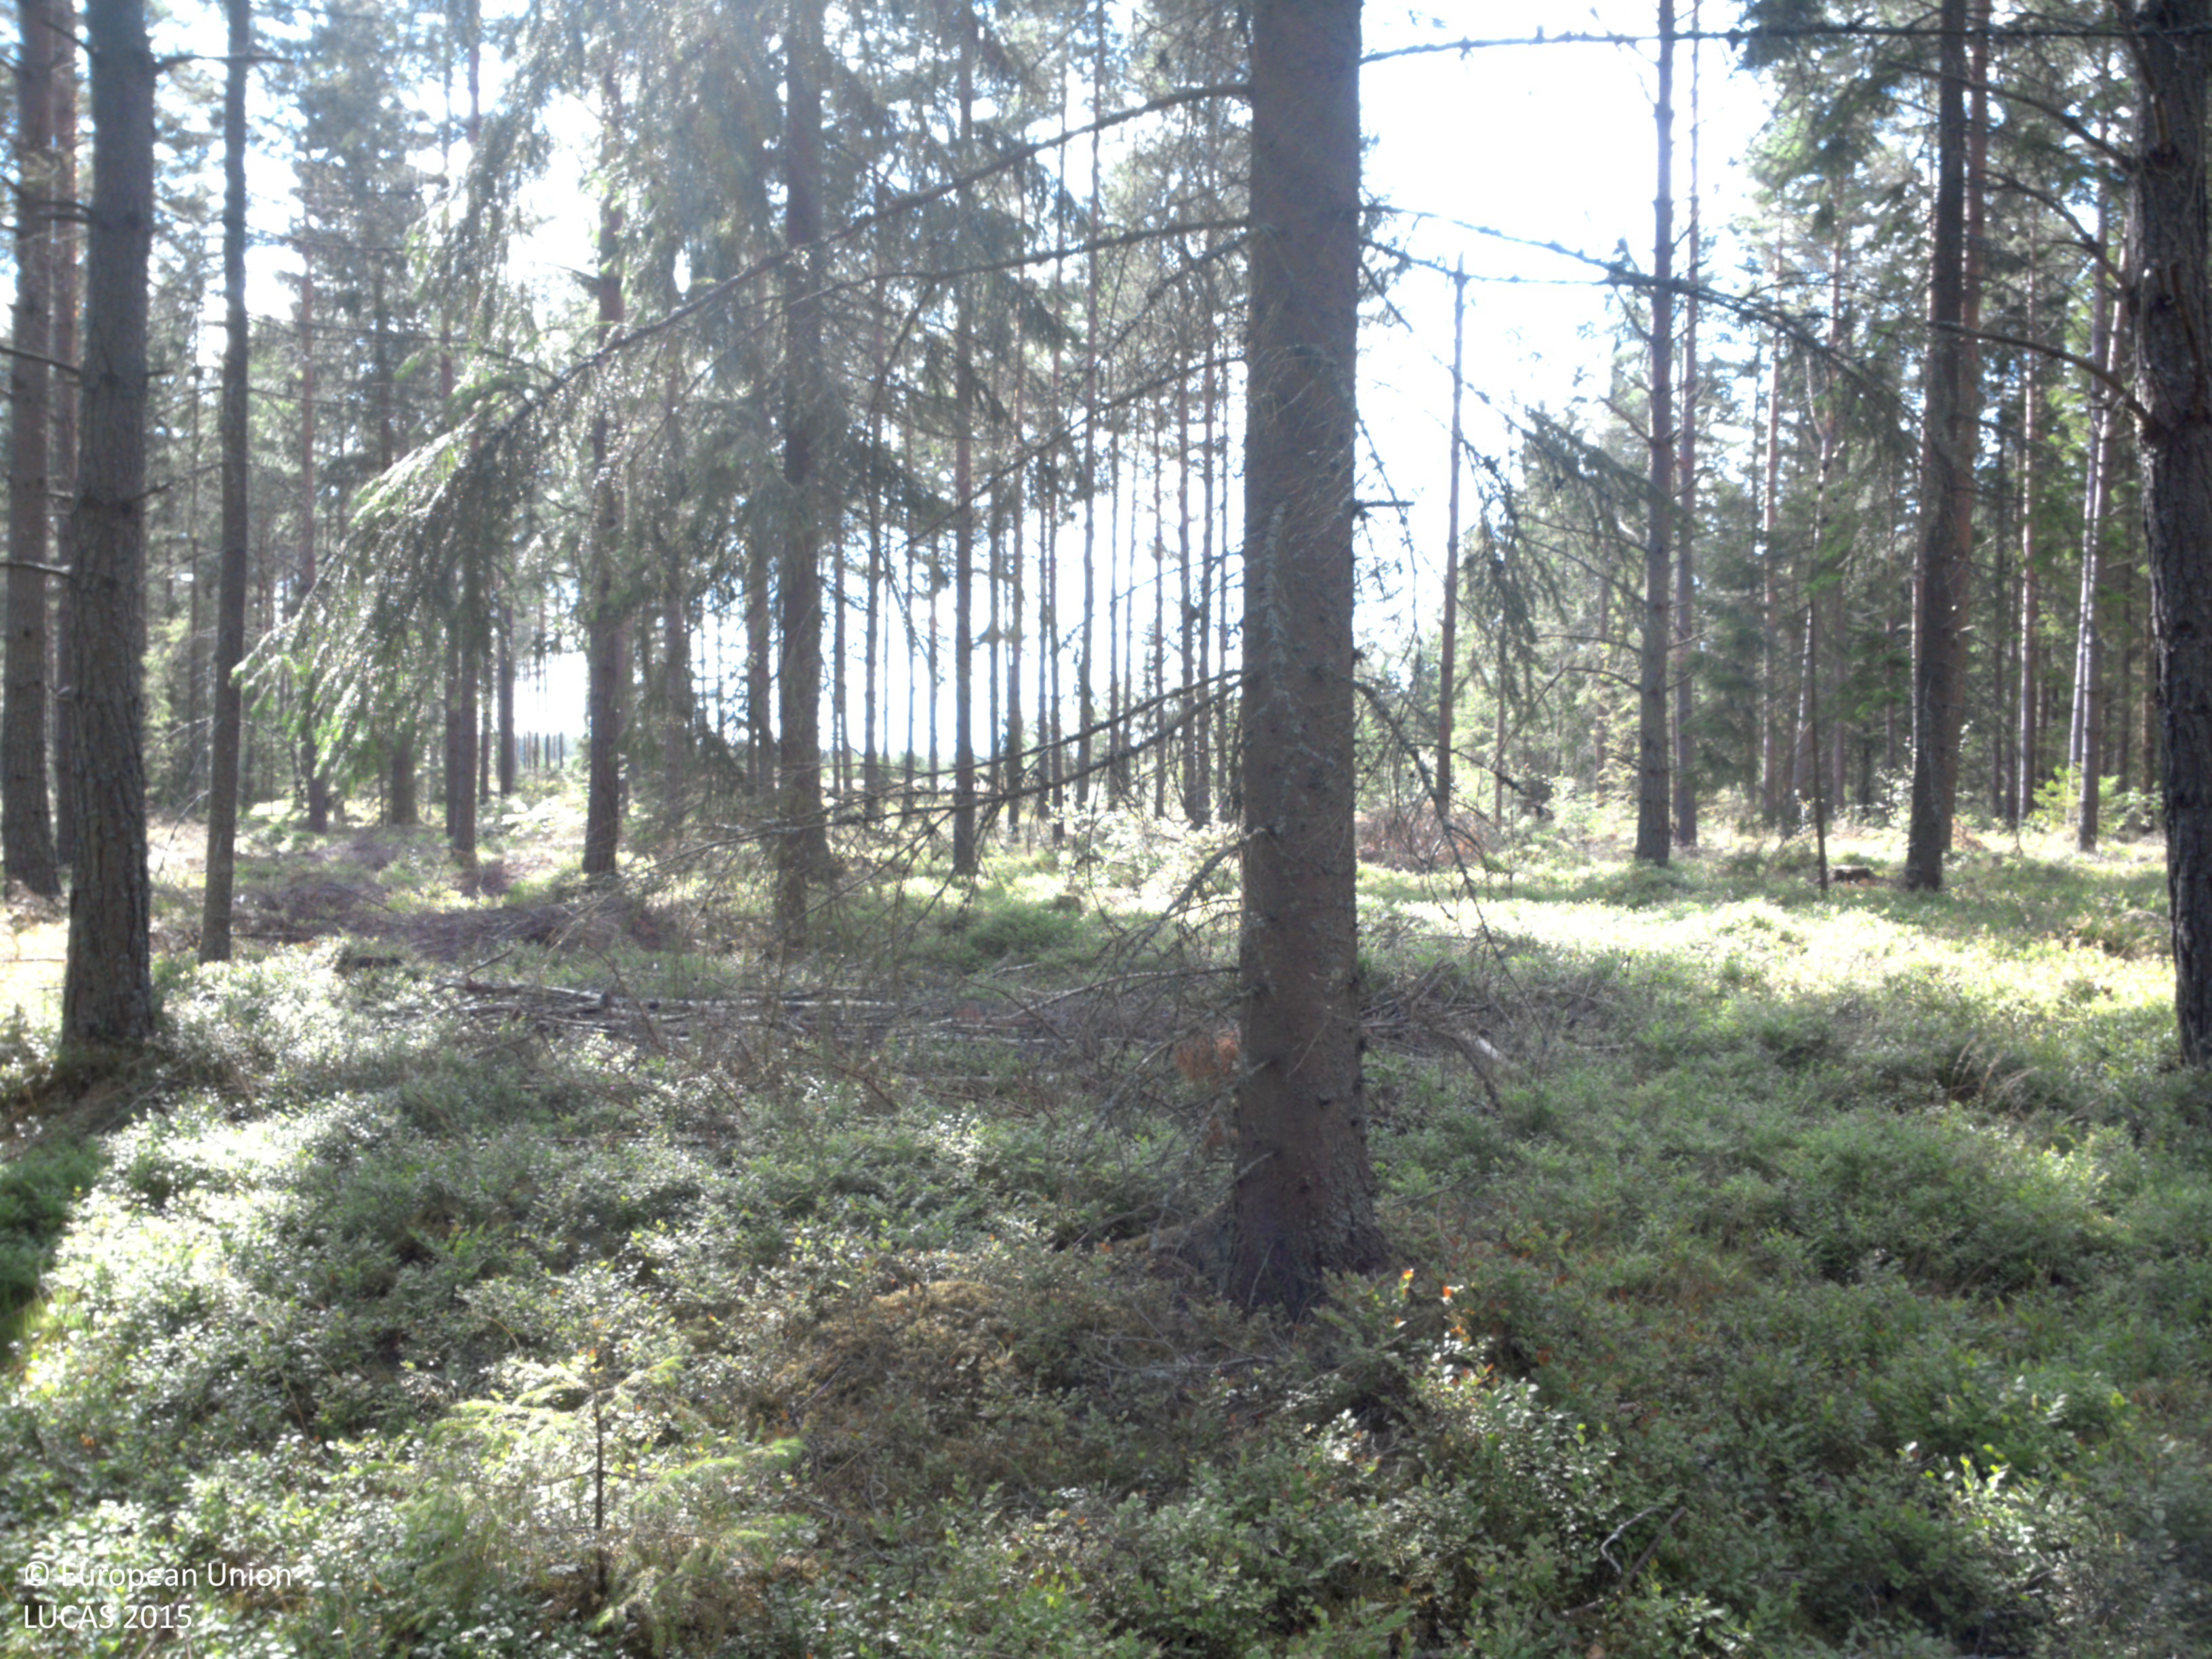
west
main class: Woodland
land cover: Pine dominated coniferous woodland
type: boreal forest
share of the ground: 50 - 75 %
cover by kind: coniferous forest trees 50 %, shrubs 45 %, lichens and mosses 5 %
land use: Forestry
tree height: > 5 m
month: July
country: SE
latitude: 58.2681
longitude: 14.0001
